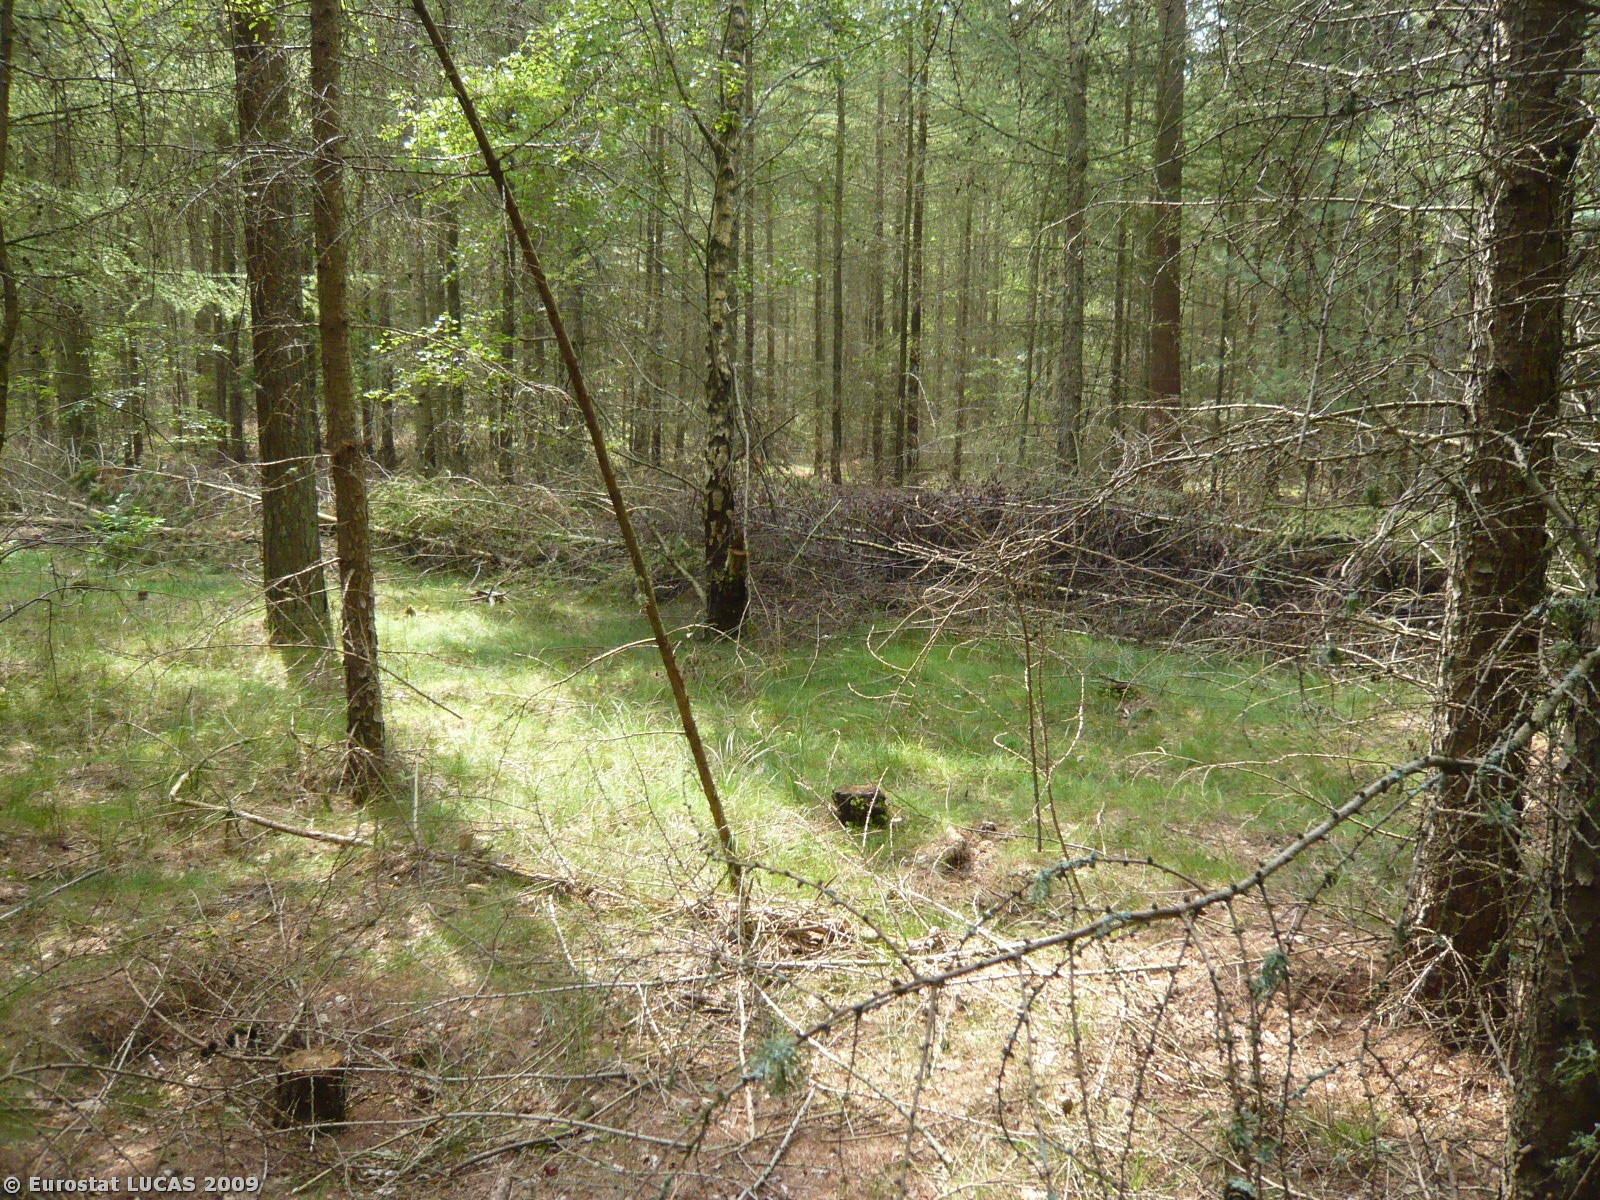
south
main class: Woodland
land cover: Coniferous woodland
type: hemiboreal forest and nemoral coniferous forest and mixed broadleaved-coniferous forest
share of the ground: > 75 %
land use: Forestry
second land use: Amenities, museums, leisure
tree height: > 5 m
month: August
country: DK
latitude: 56.0447
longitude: 12.1009
